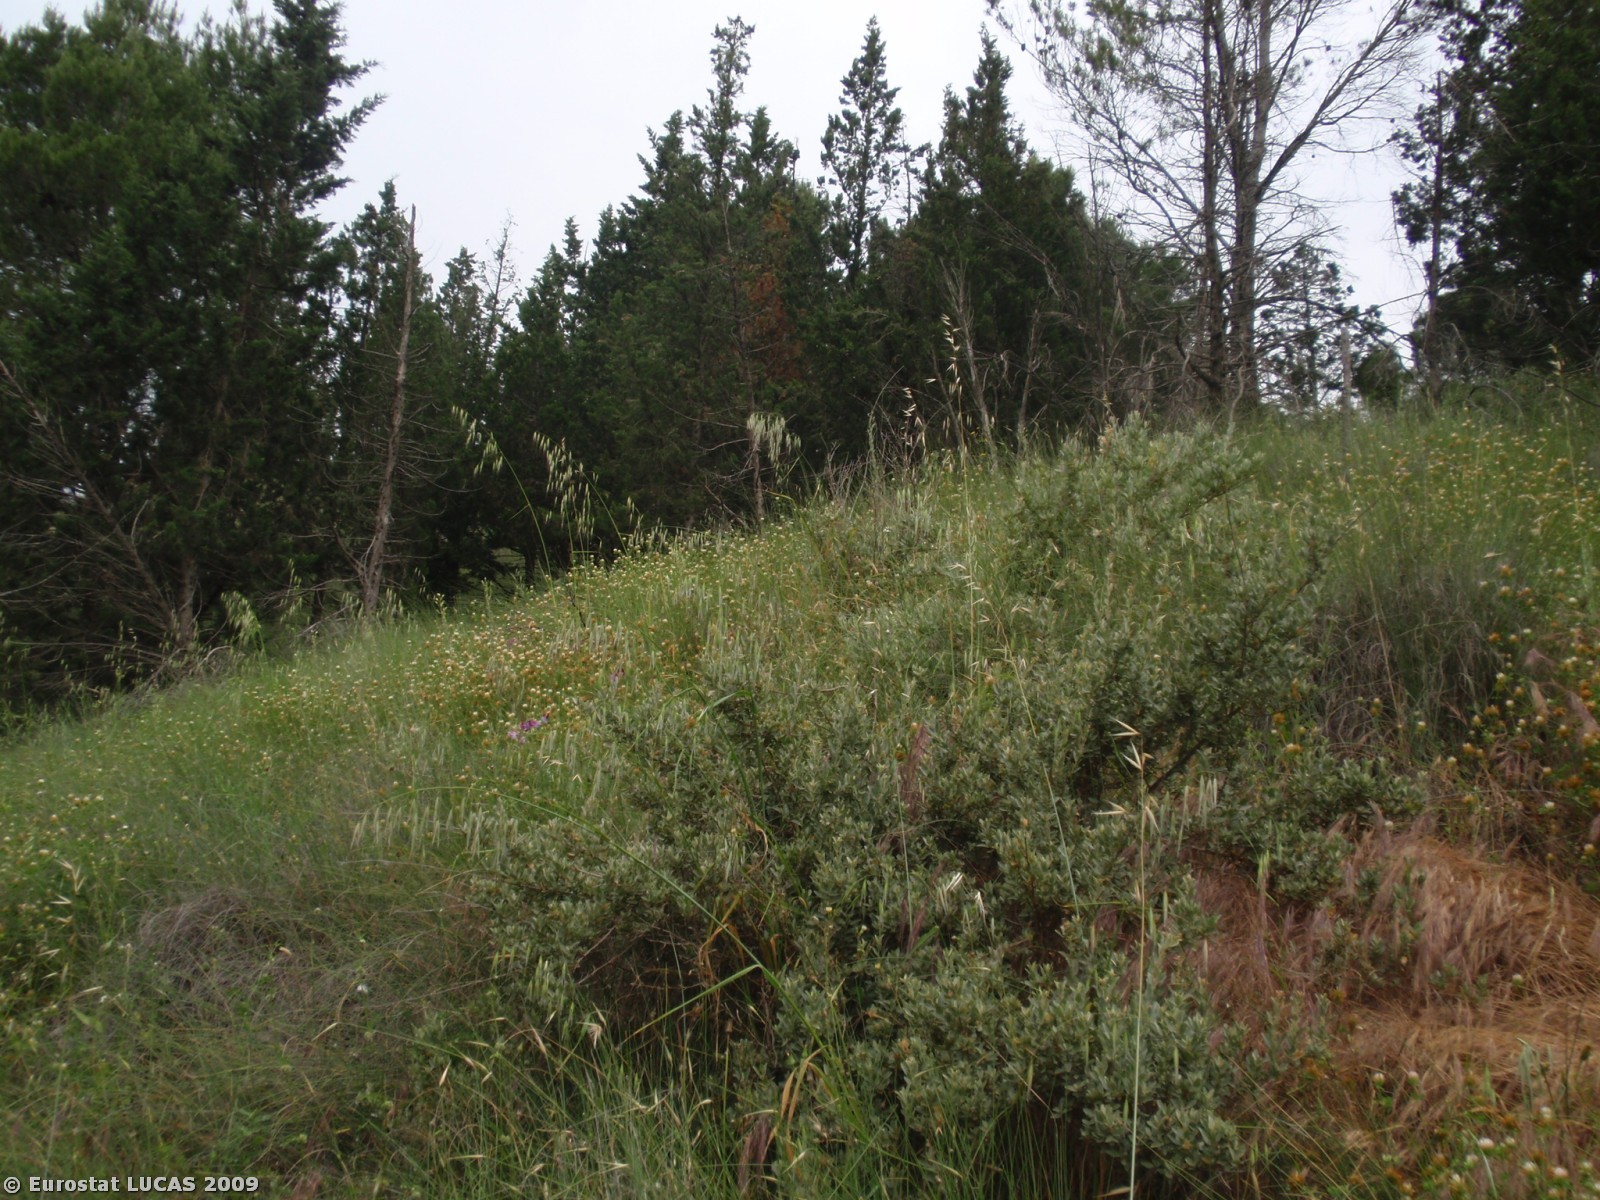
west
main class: Woodland
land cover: Coniferous woodland
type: alpine coniferous forest
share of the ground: > 75 %
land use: Forestry
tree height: > 5 m
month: May
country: IT
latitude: 40.3744
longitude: 16.5591
